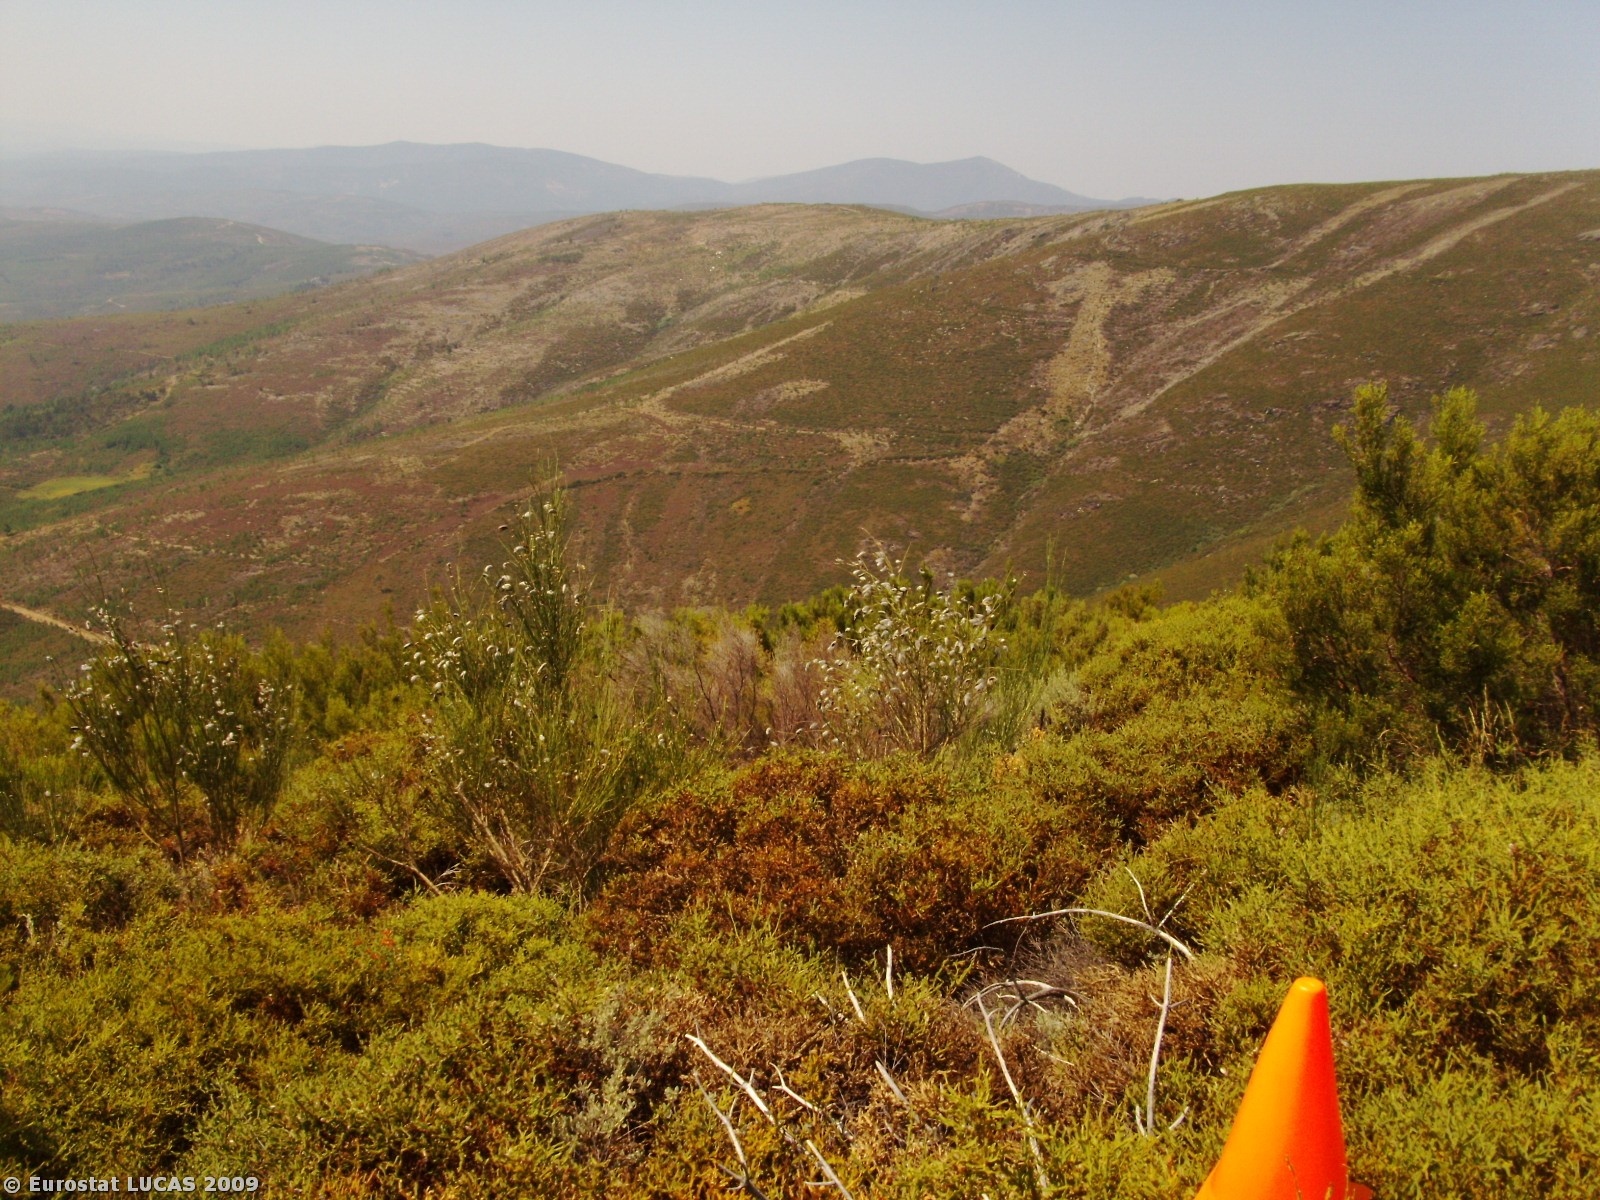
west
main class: Shrubland
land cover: Shrubland without tree cover
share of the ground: > 75 %
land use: Forestry
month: August
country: PT
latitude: 40.2607
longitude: -7.6418
